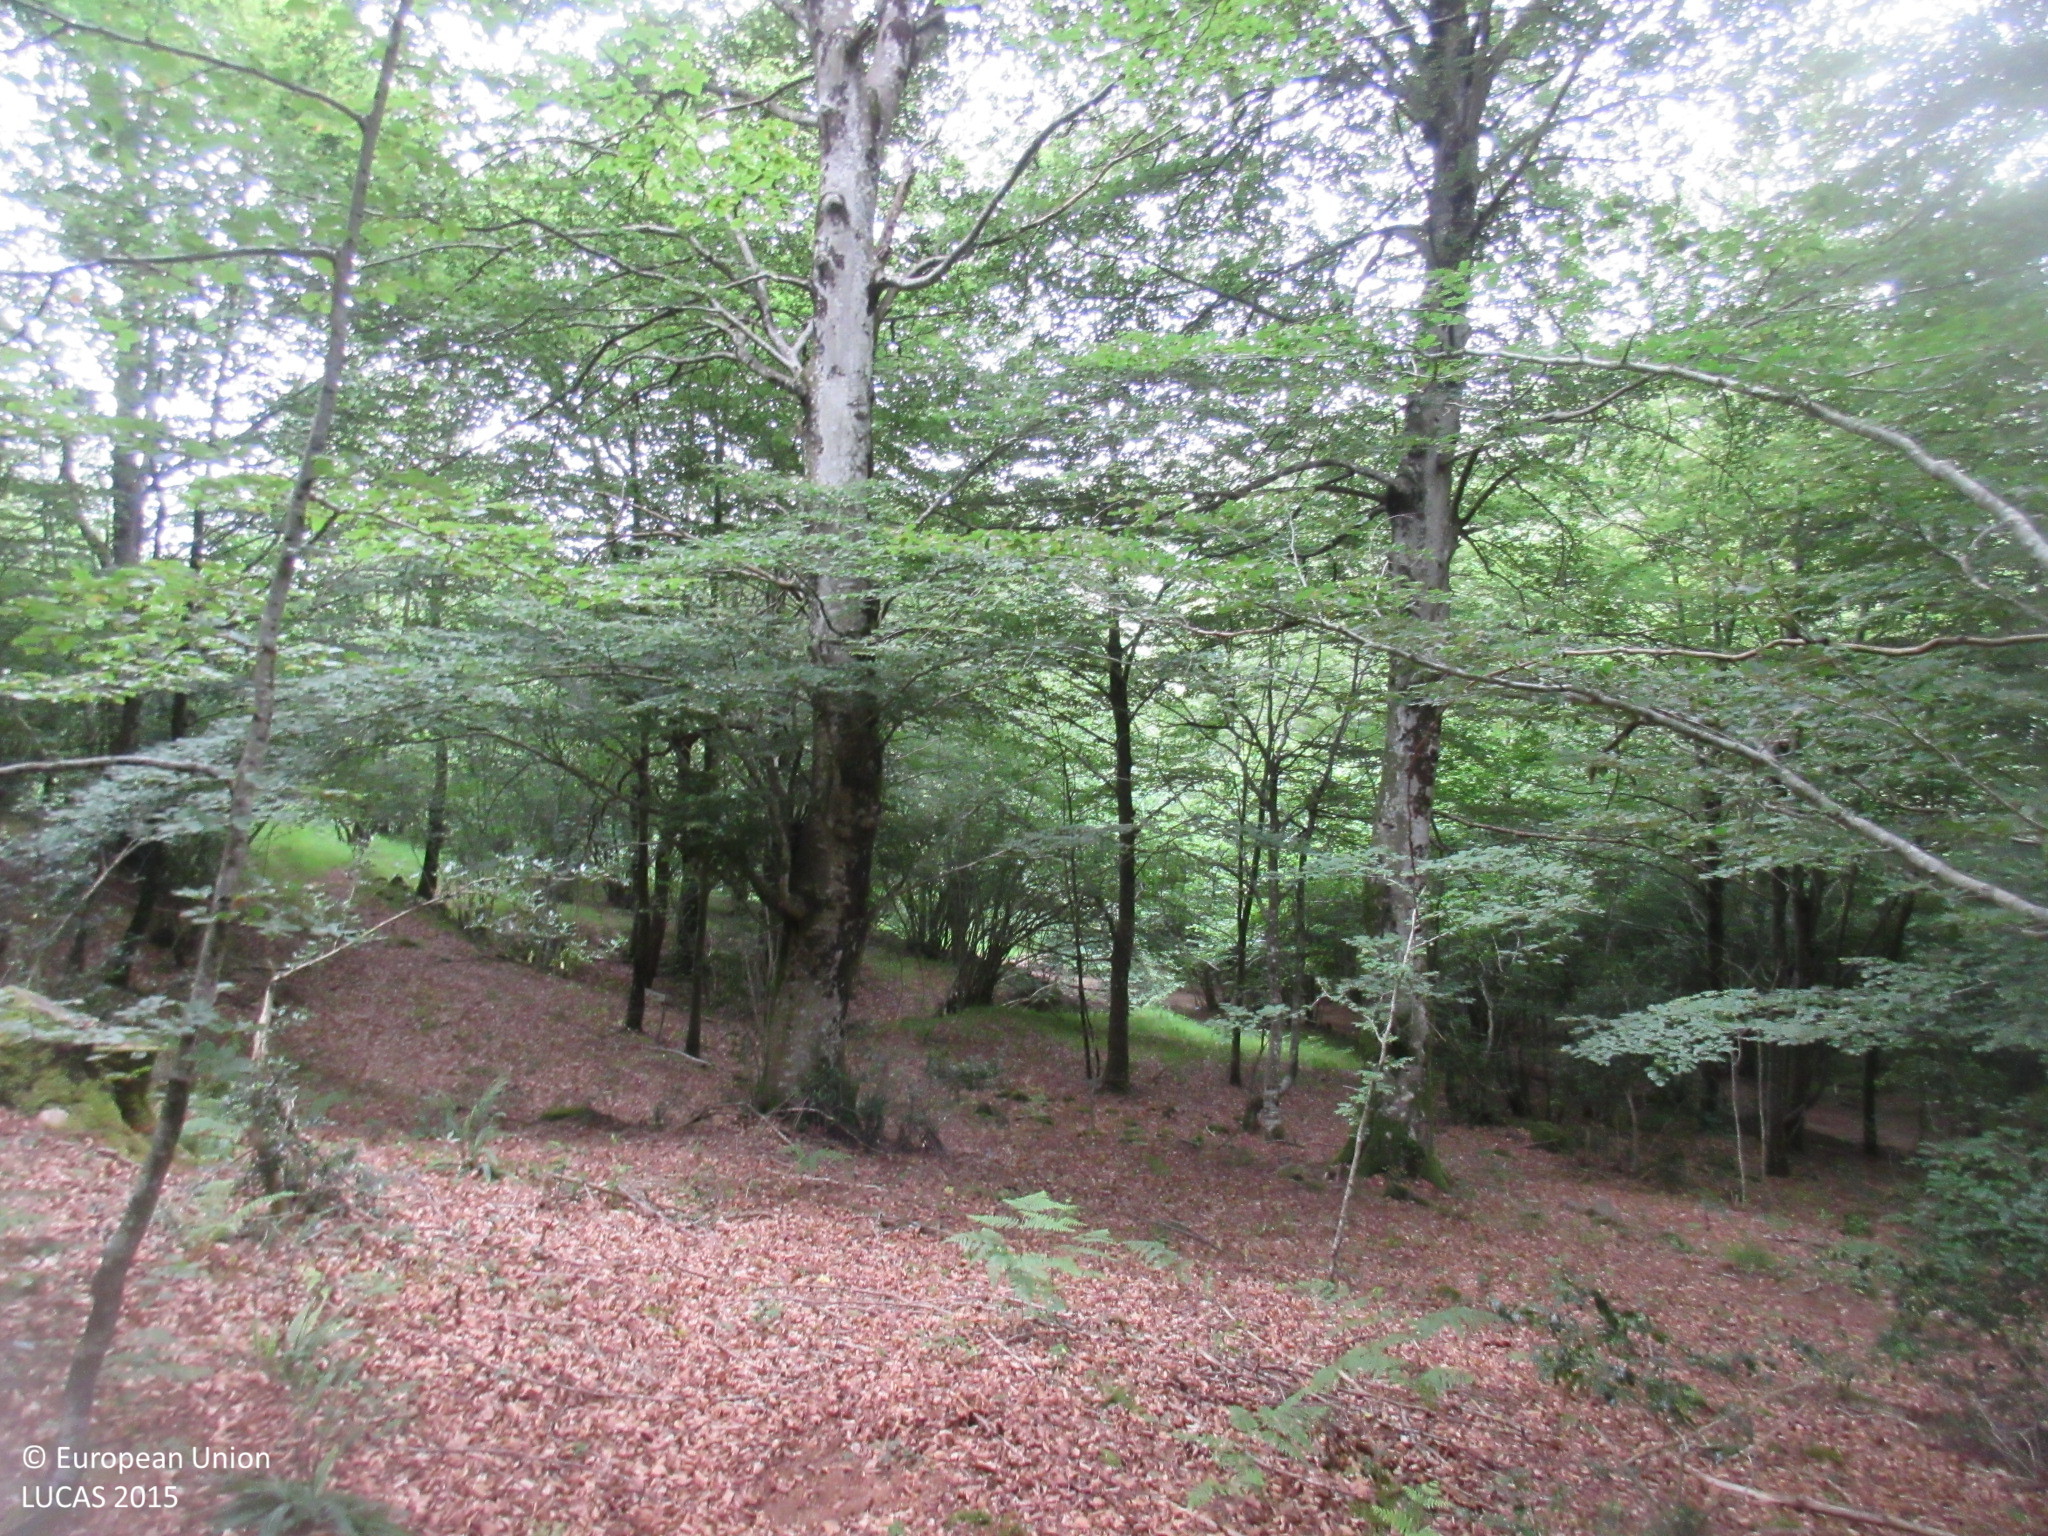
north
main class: Woodland
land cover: Broadleaved woodland
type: beech forest
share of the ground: > 75 %
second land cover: Shrubland without tree cover
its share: < 10 %
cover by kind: broadleaved forest trees 100 %
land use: Forestry
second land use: Agriculture (excluding fallow land and kitchen gardens)
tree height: > 5 m
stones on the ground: 10 - 25 %
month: July
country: ES
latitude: 43.0763
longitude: -4.0634
